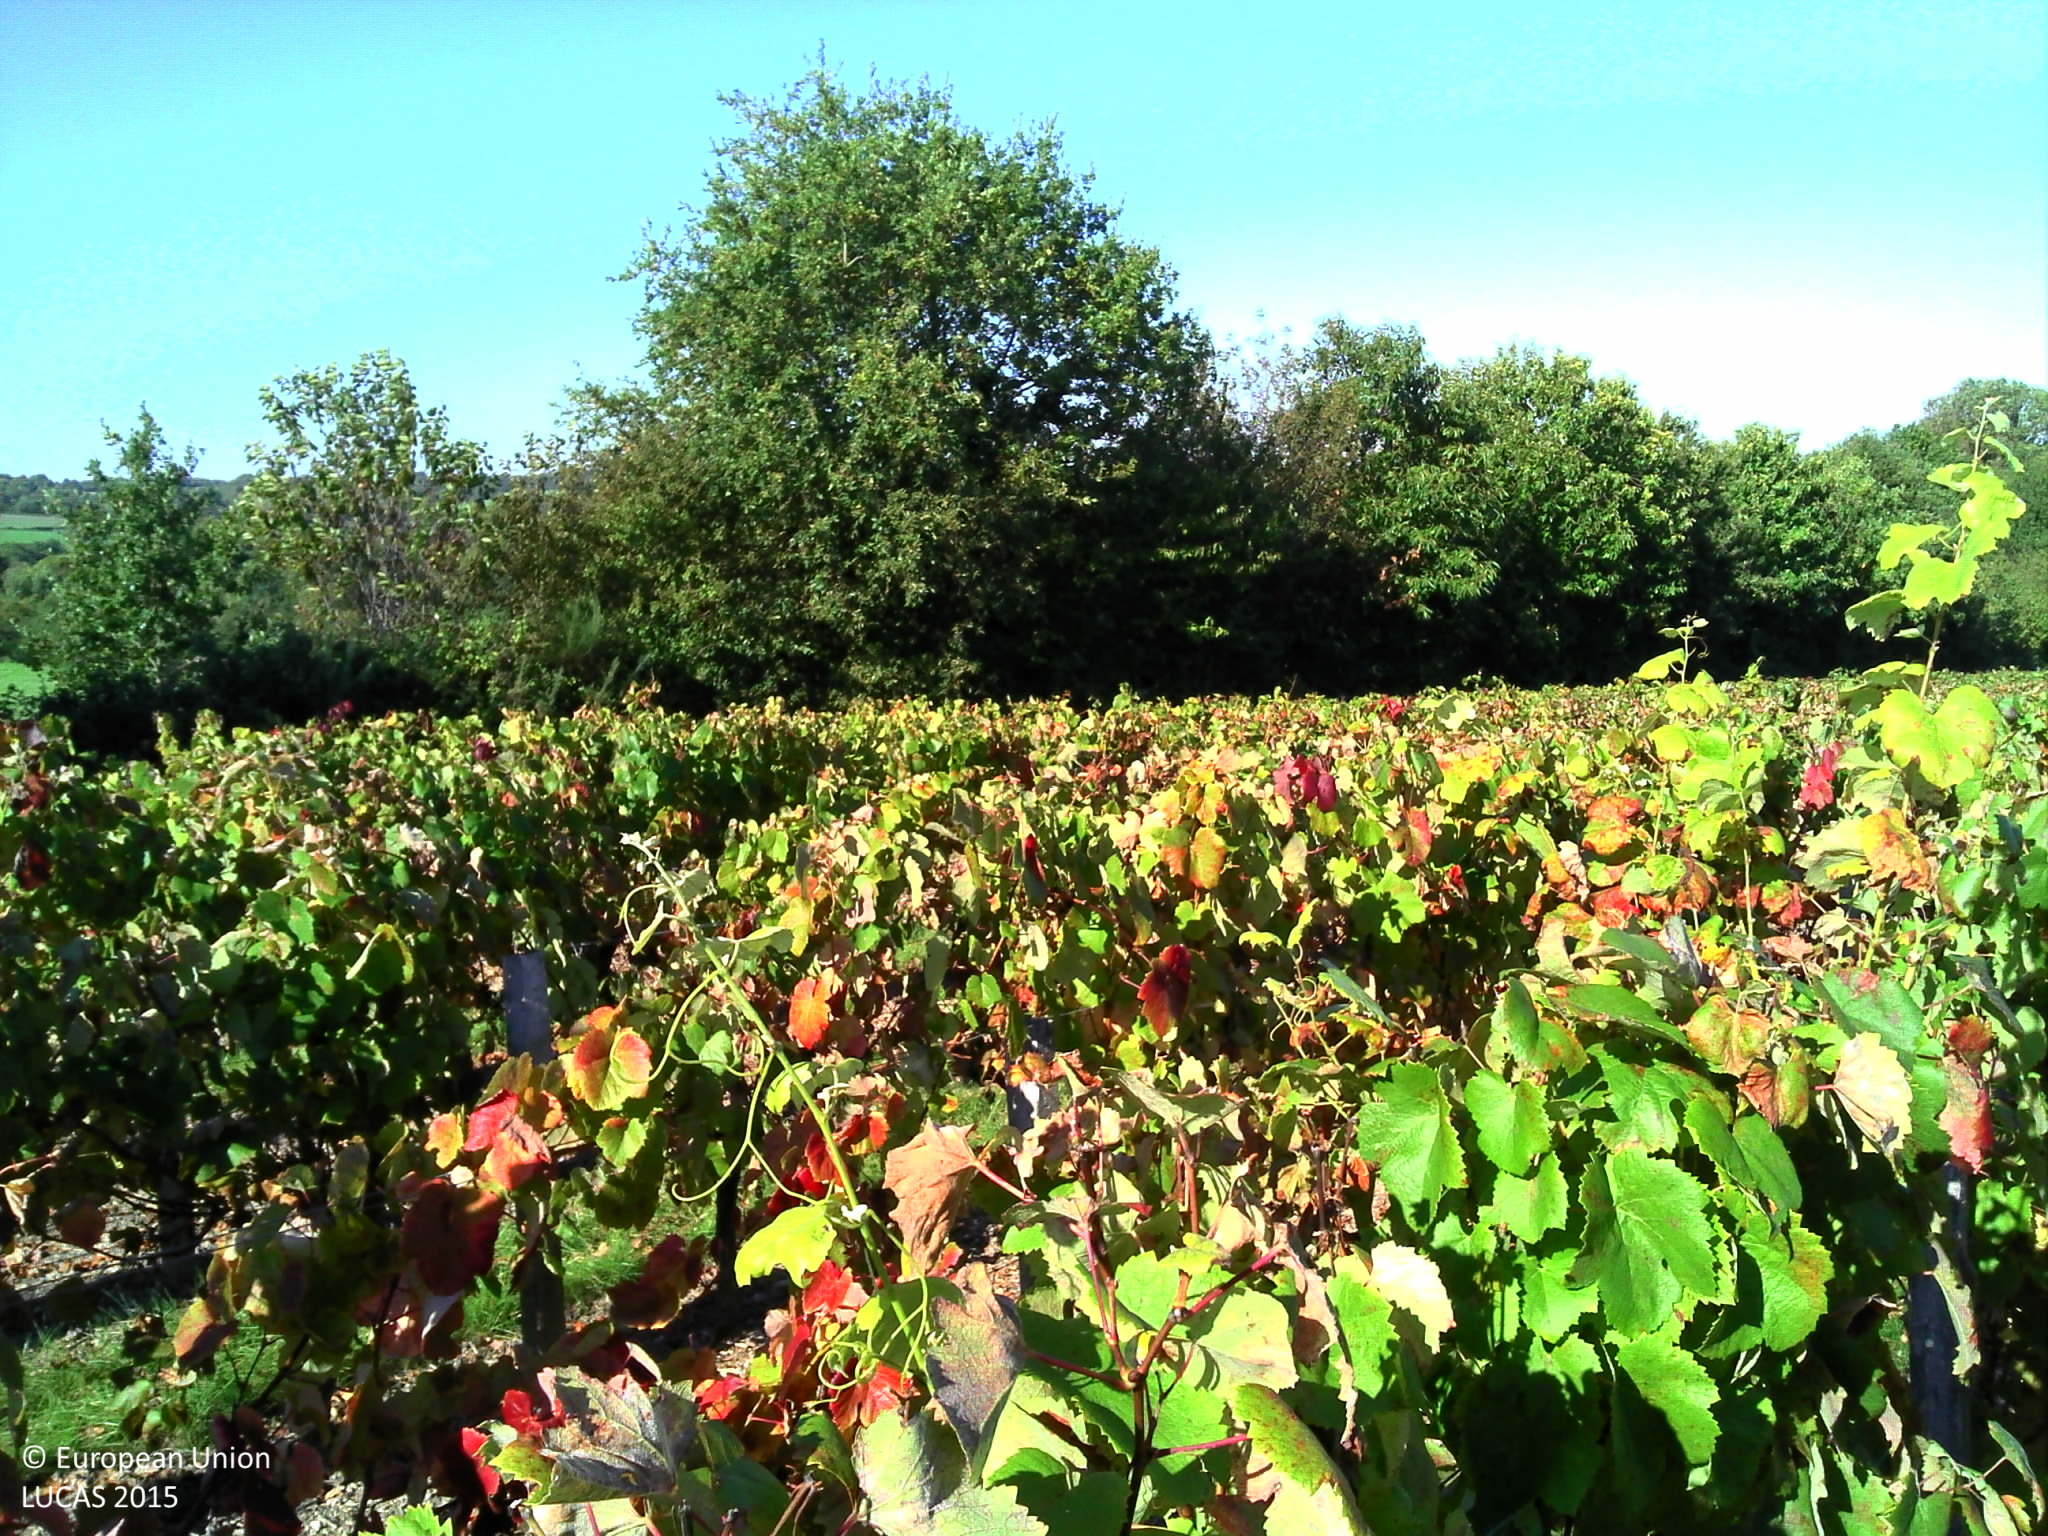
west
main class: Cropland
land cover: Vineyards
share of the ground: > 75 %
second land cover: Other bare soil
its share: > 75 %
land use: Agriculture (excluding fallow land and kitchen gardens)
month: September
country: FR
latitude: 46.5306
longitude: -1.3132
